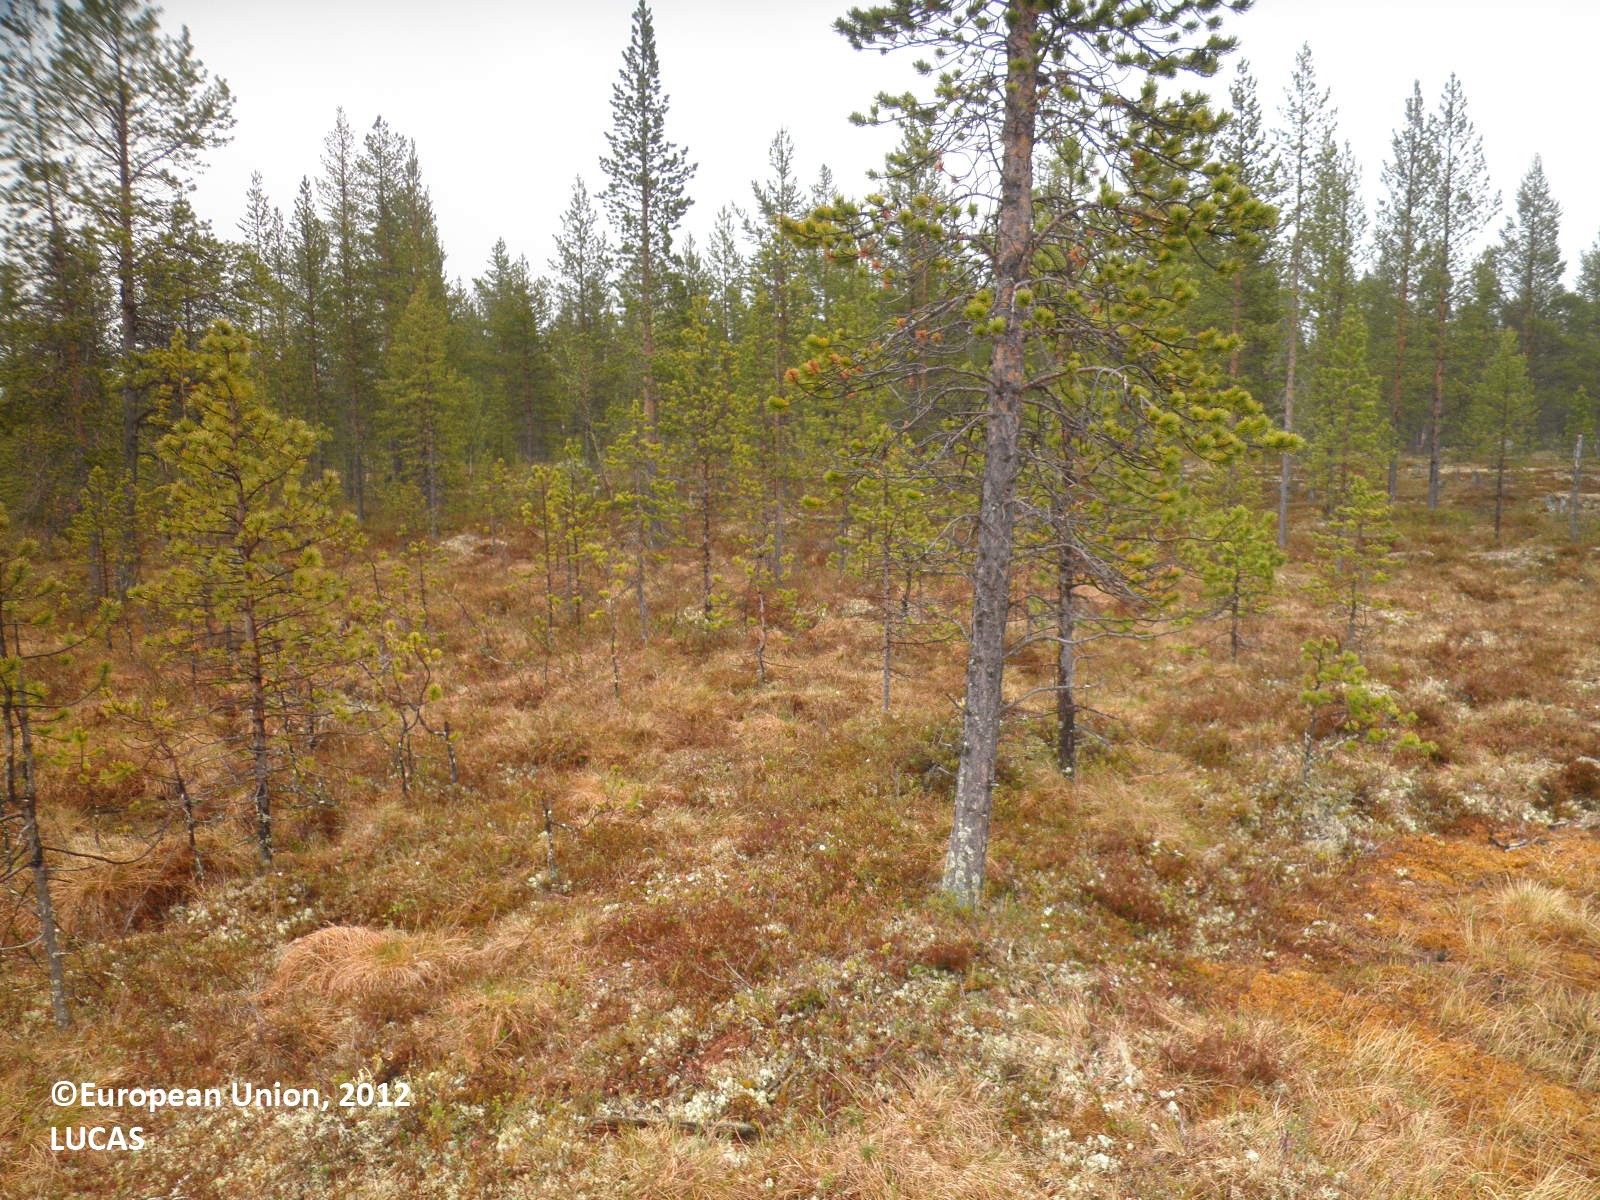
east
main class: Woodland
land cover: Pine dominated coniferous woodland
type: boreal forest
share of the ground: 10 - 25 %
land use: Forestry
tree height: > 5 m
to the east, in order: Pine dominated coniferous woodland; Tracks; Pine dominated mixed woodland; Pine dominated coniferous woodland; Peatbogs
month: June
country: FI
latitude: 69.1158
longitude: 27.2292
